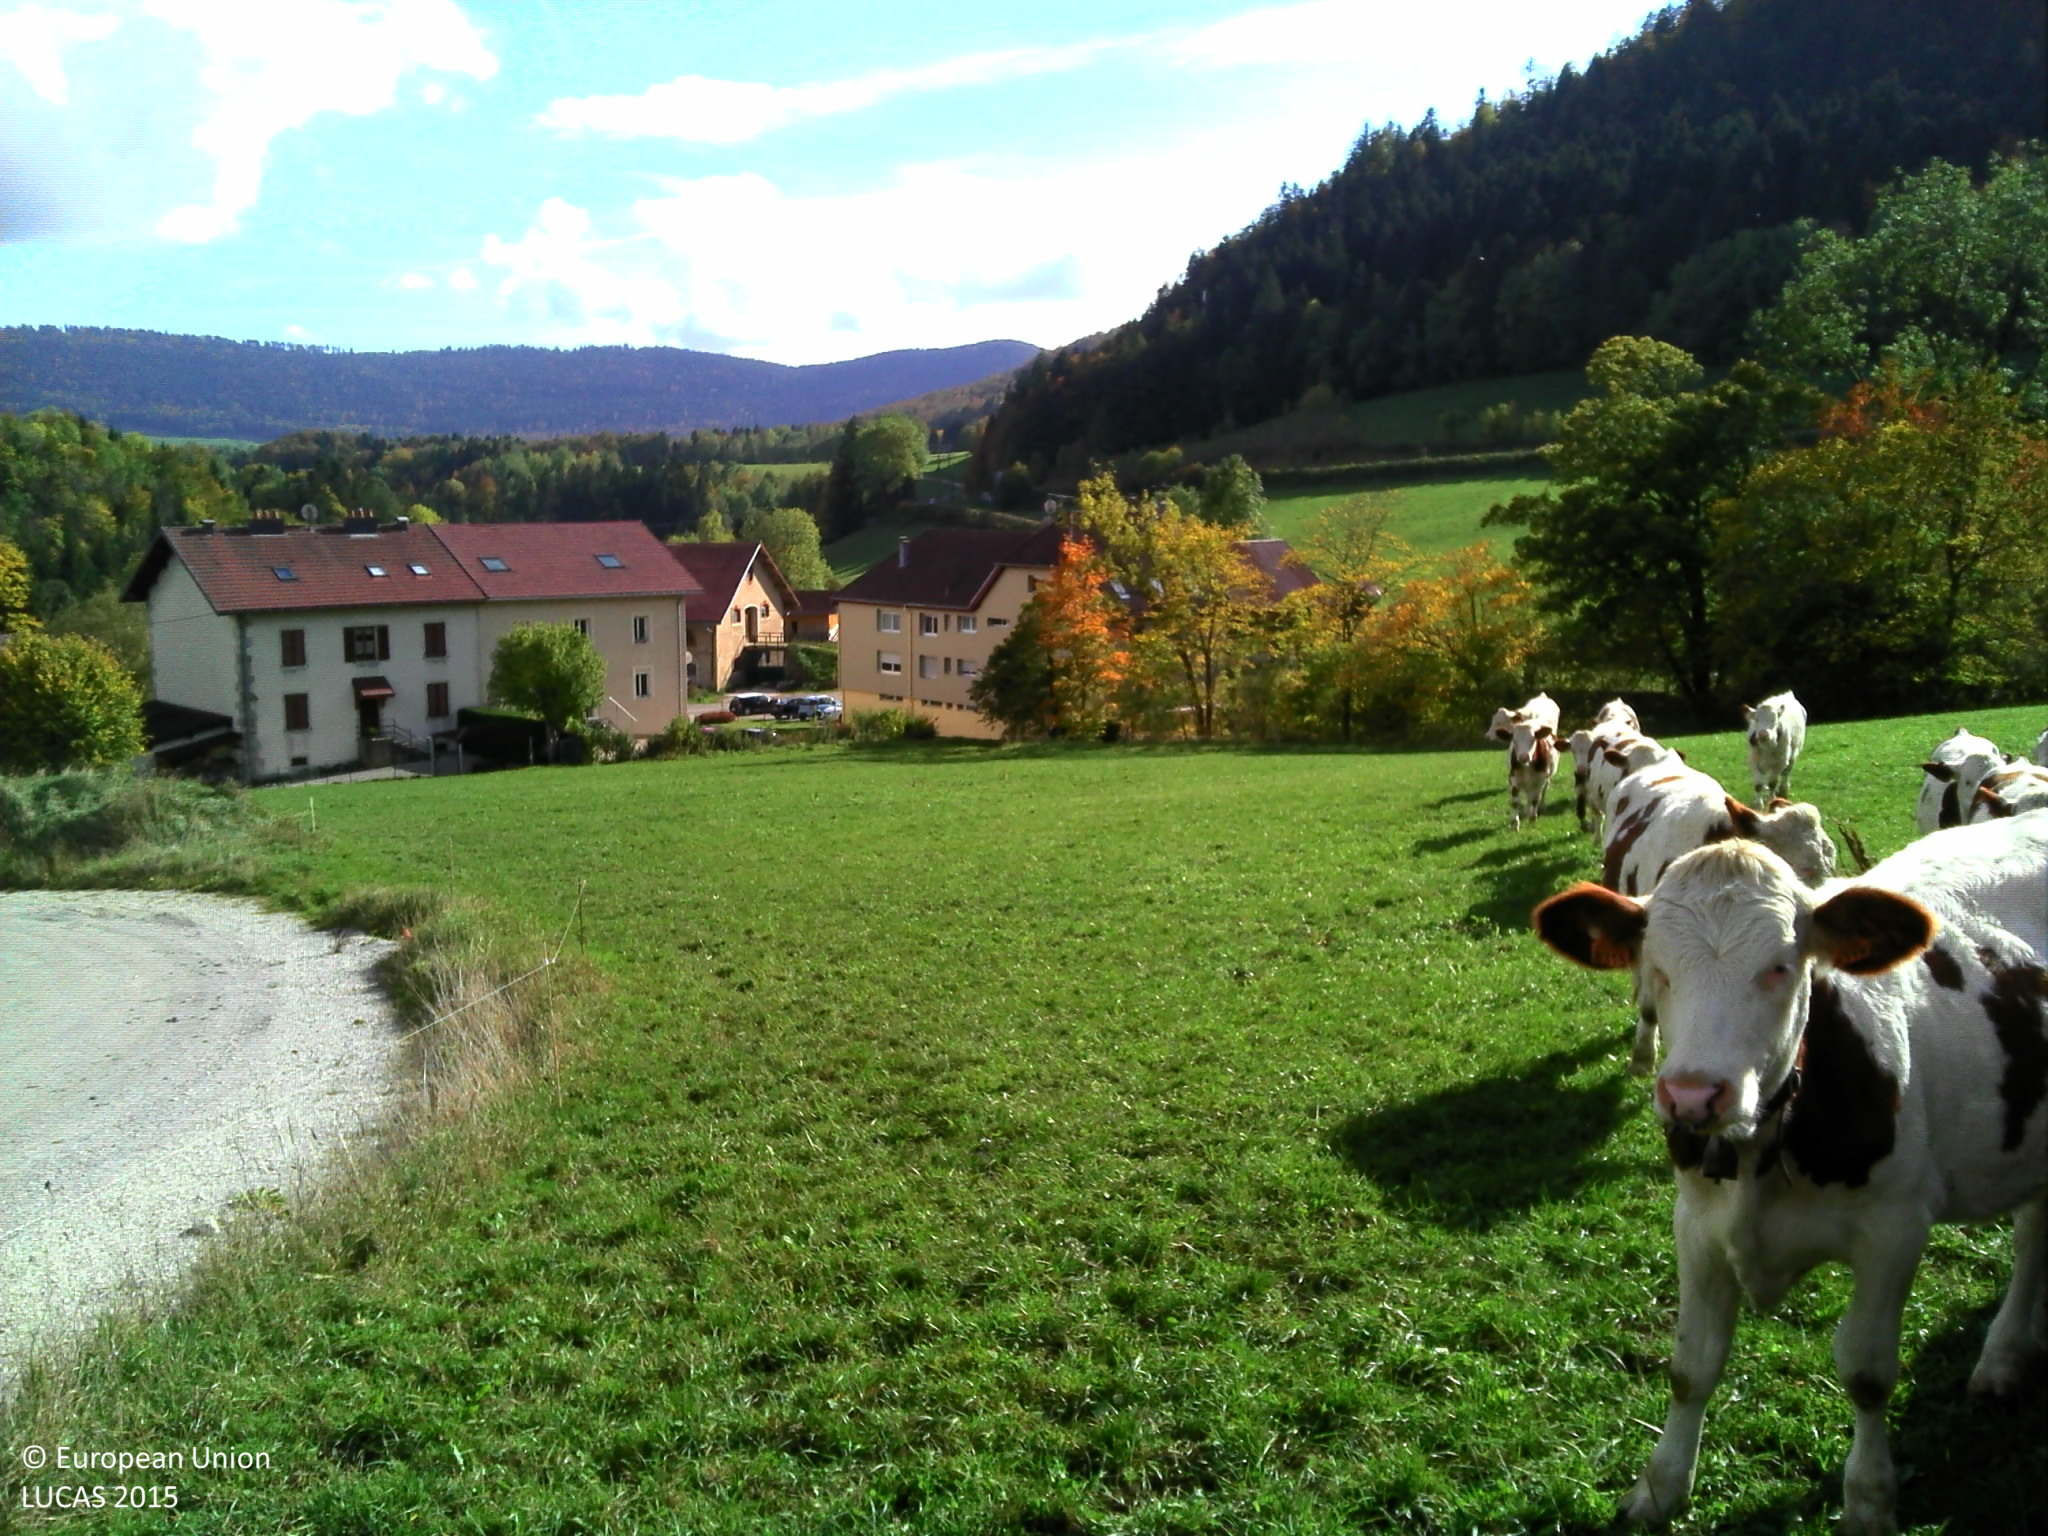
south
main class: Grassland
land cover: Grassland without tree/shrub cover
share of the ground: > 75 %
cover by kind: herbaceous plants 100 %
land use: Agriculture (excluding fallow land and kitchen gardens)
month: October
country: FR
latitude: 46.7406
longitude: 6.3773
